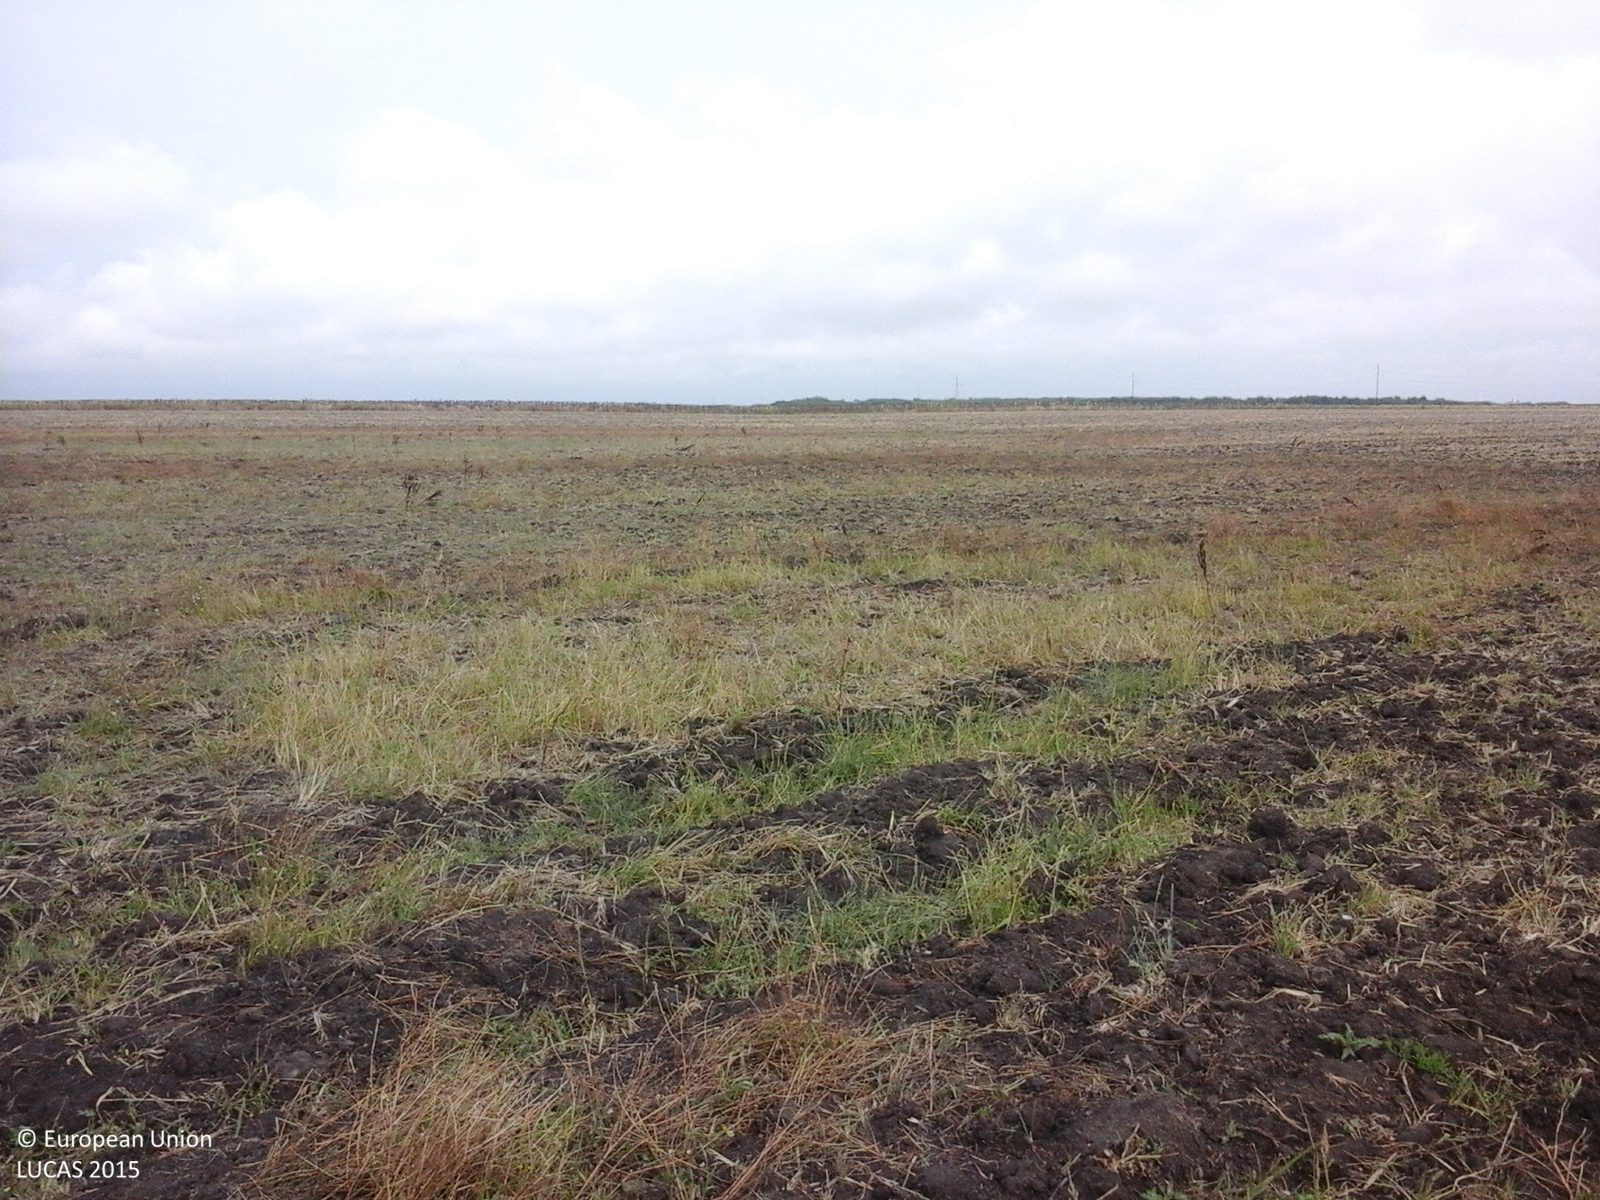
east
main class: Cropland
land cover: Common wheat
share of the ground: 10 - 25 %
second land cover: Spontaneously vegetated surfaces
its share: 25 - 50 %
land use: Agriculture (excluding fallow land and kitchen gardens)
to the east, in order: Common wheat; Spontaneously vegetated surfaces; Grass margins; Sunflower
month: August
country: RO
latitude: 46.0883
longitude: 20.6701
